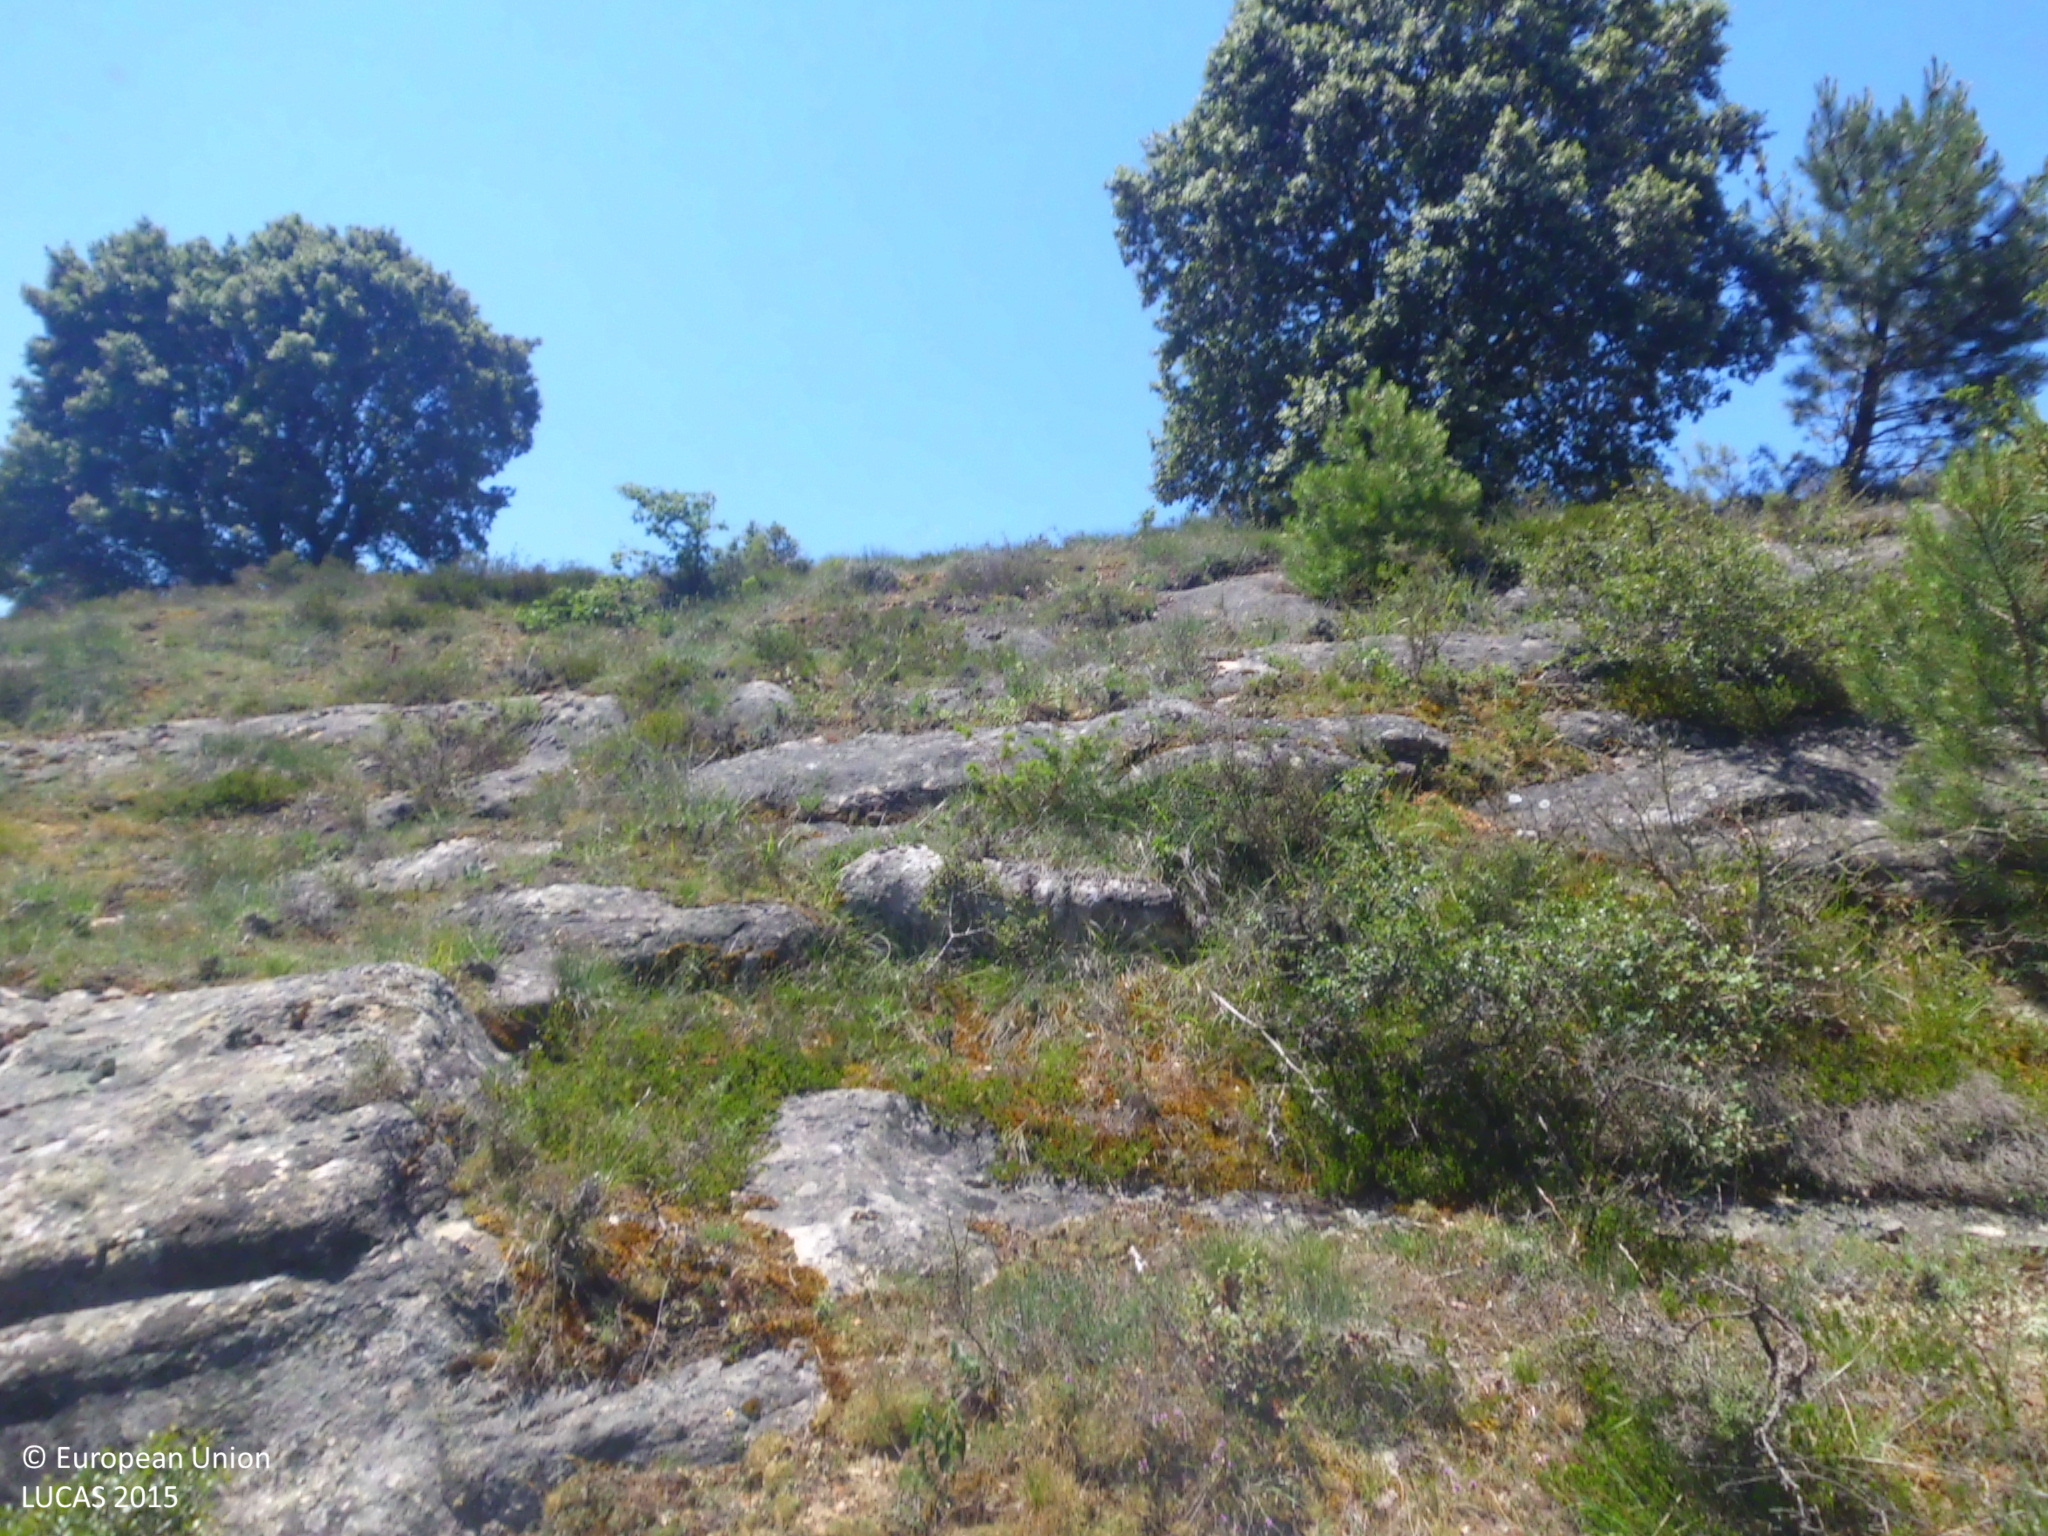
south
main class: Shrubland
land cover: Shrubland with sparse tree cover
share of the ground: 25 - 50 %
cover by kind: herbaceous plants 50 %, shrubs 35 %, consolidated bare surface 10 %, coniferous forest trees 5 %
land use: Semi-natural and natural areas not in use
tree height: < 5 m
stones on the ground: 10 - 25 %
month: June
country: ES
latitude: 42.8944
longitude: -3.5218
